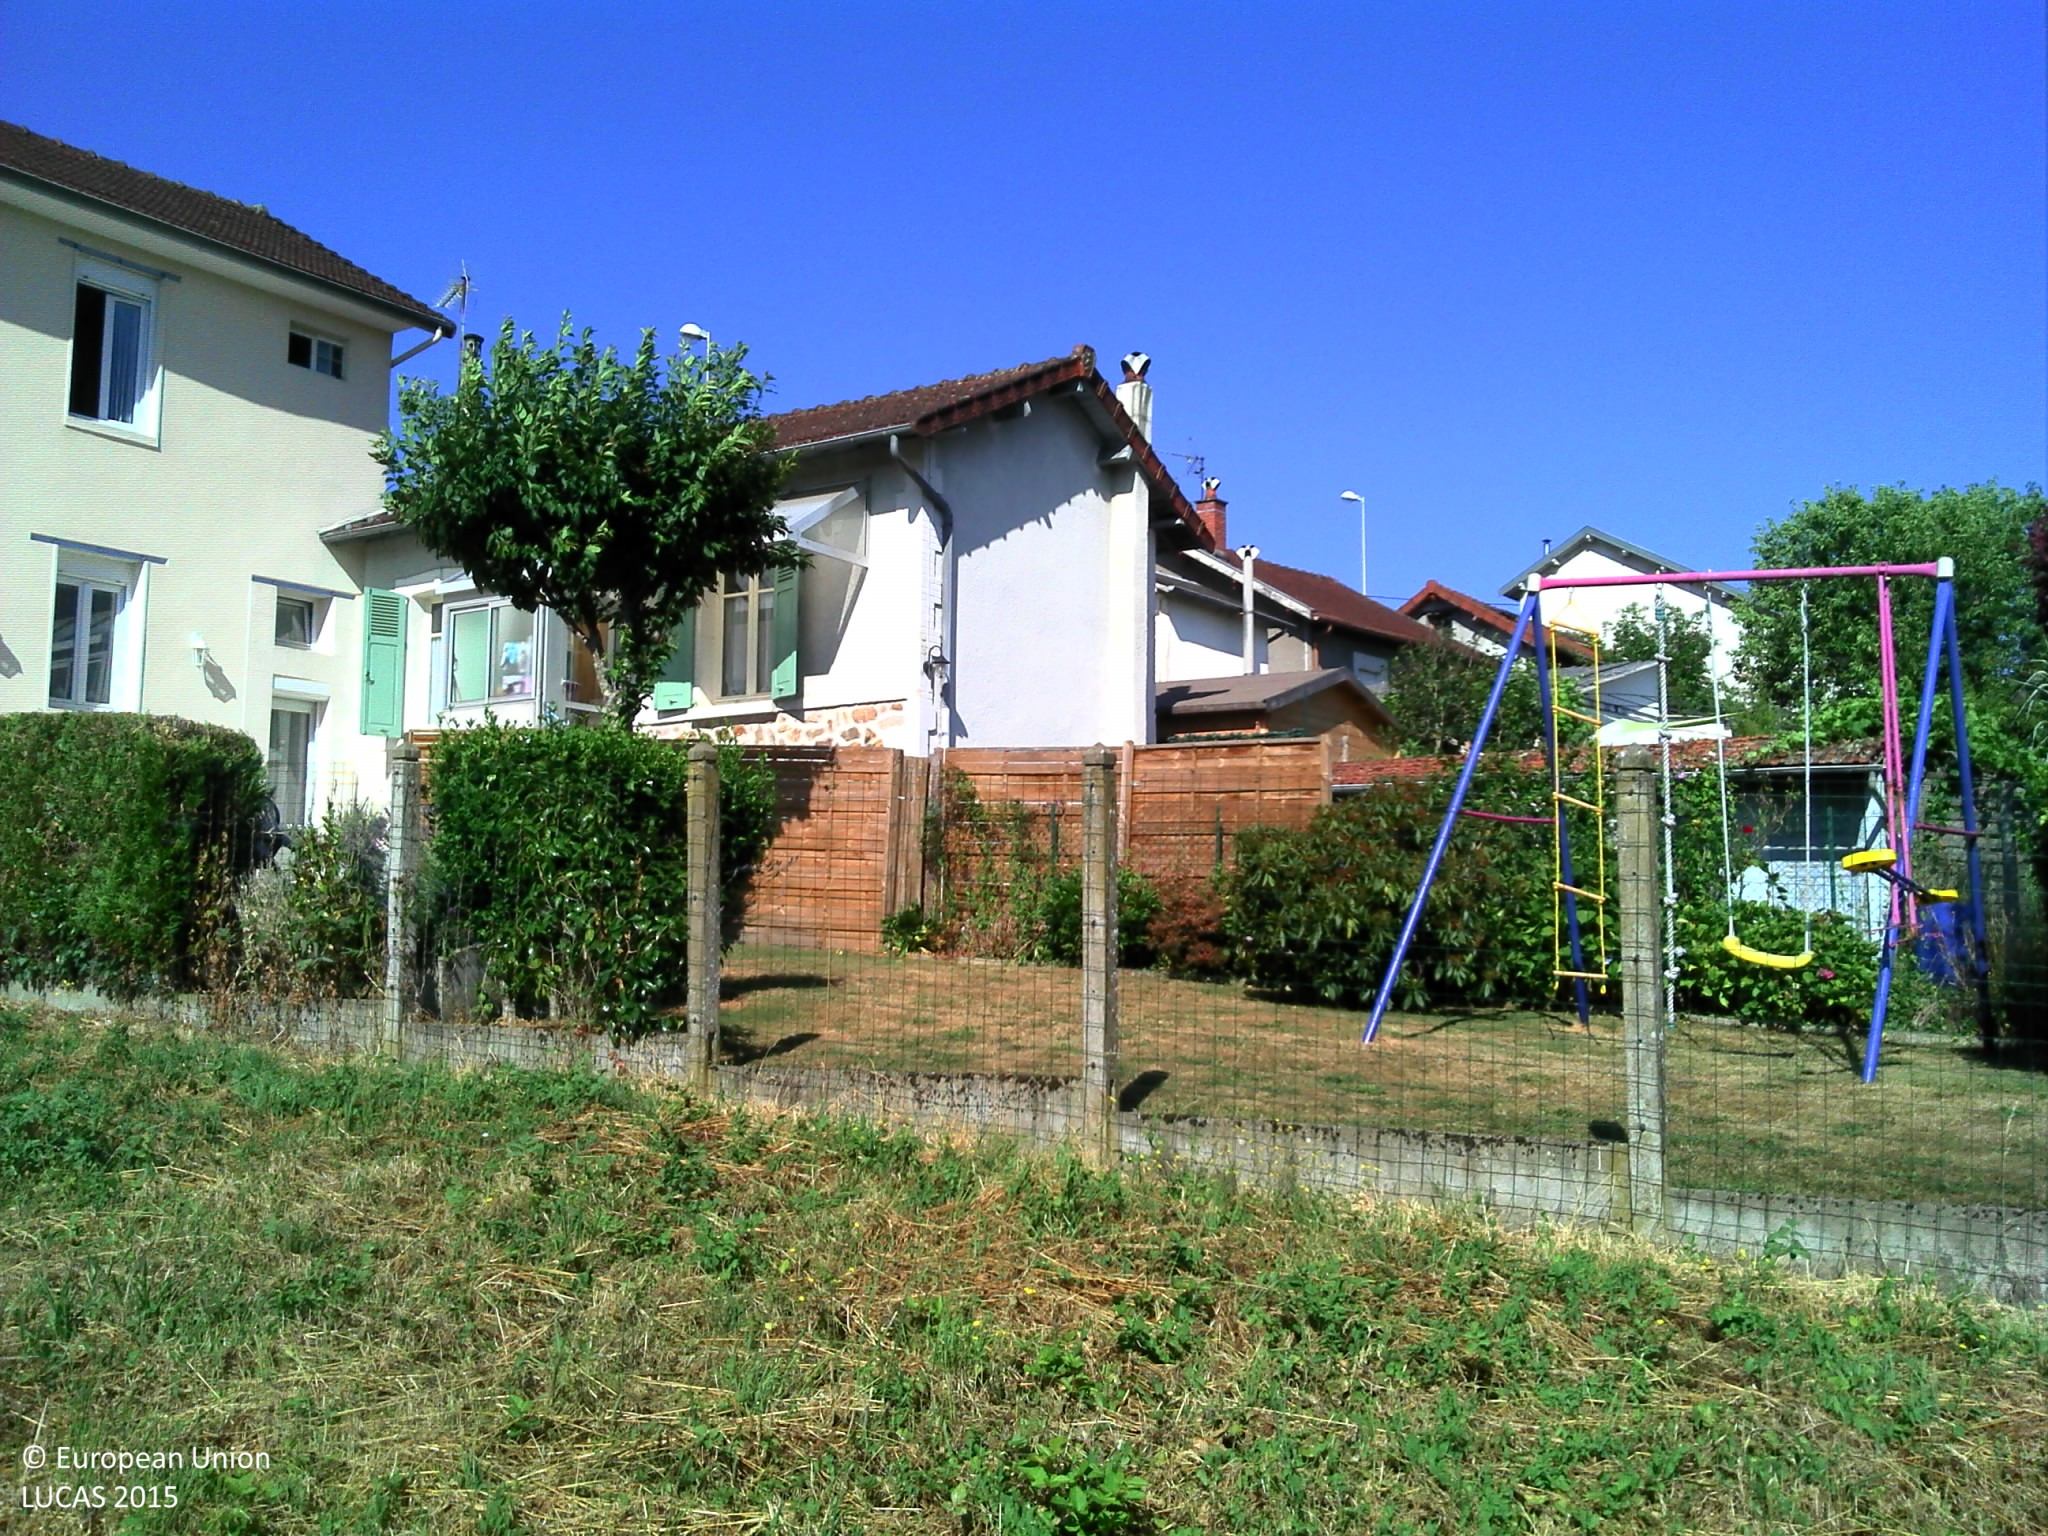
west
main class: Grassland
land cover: Grassland with sparse tree/shrub cover
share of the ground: > 75 %
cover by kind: herbaceous plants 90 %, broadleaved forest trees 5 %
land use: Residential
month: July
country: FR
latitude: 45.8490
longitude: 1.2728
